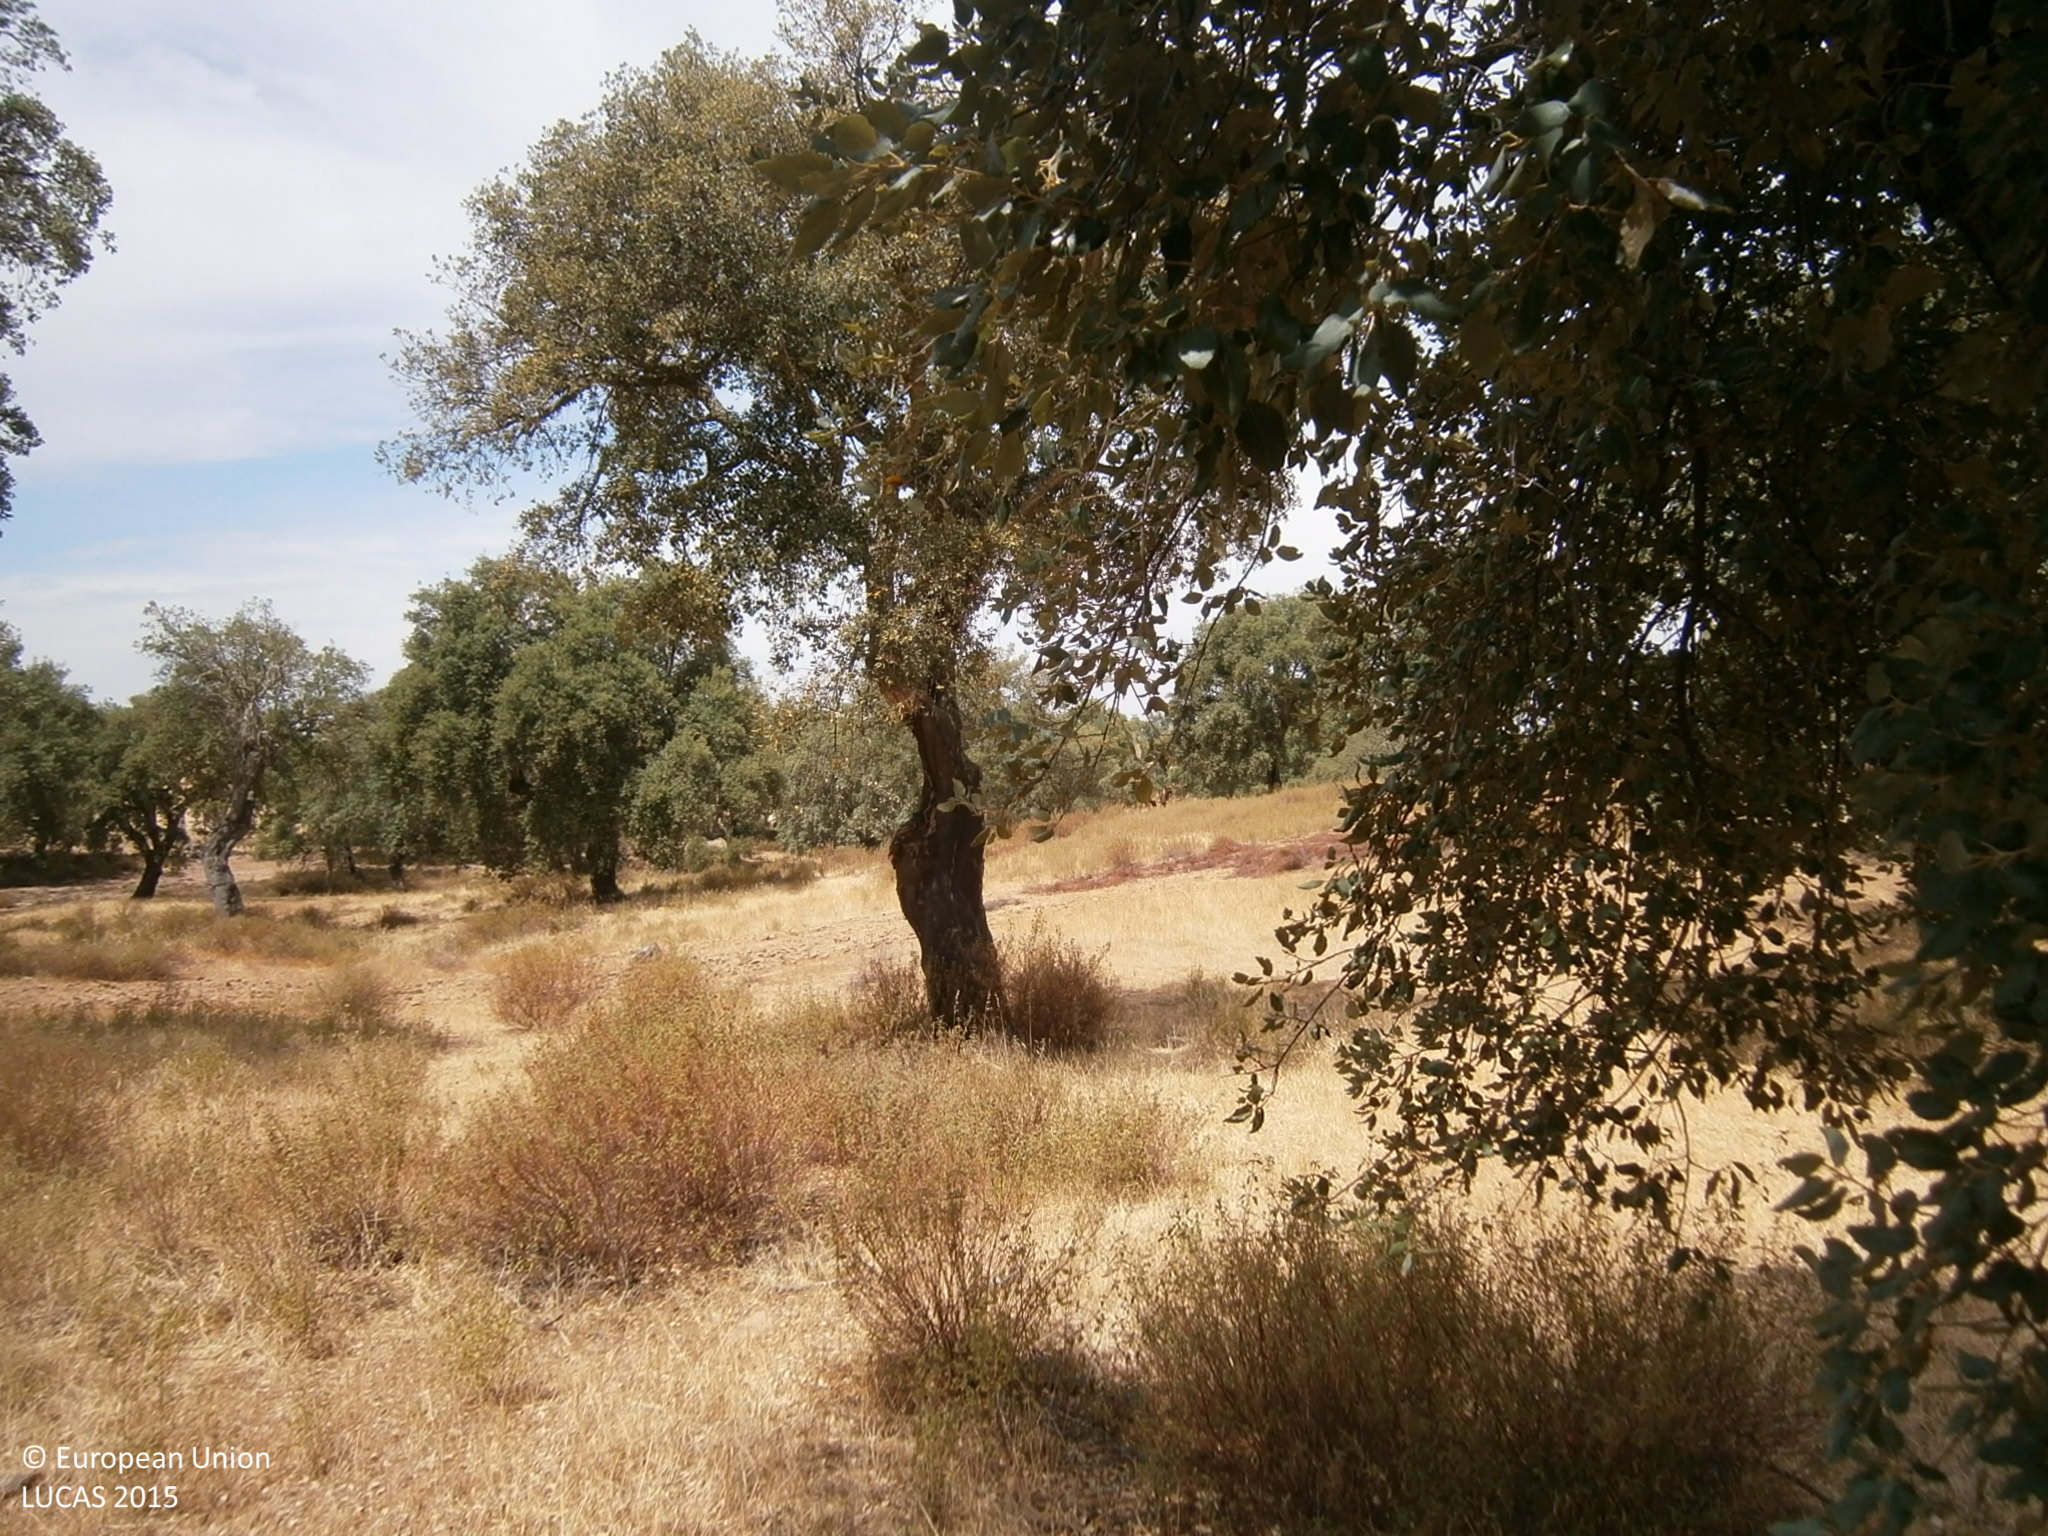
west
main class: Woodland
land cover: Broadleaved woodland
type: broadleaved evergreen forest
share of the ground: > 75 %
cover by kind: herbaceous plants 60 %, broadleaved forest trees 30 %, shrubs 10 %
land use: Forestry
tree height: > 5 m
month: July
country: ES
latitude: 38.7931
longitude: -6.9814
